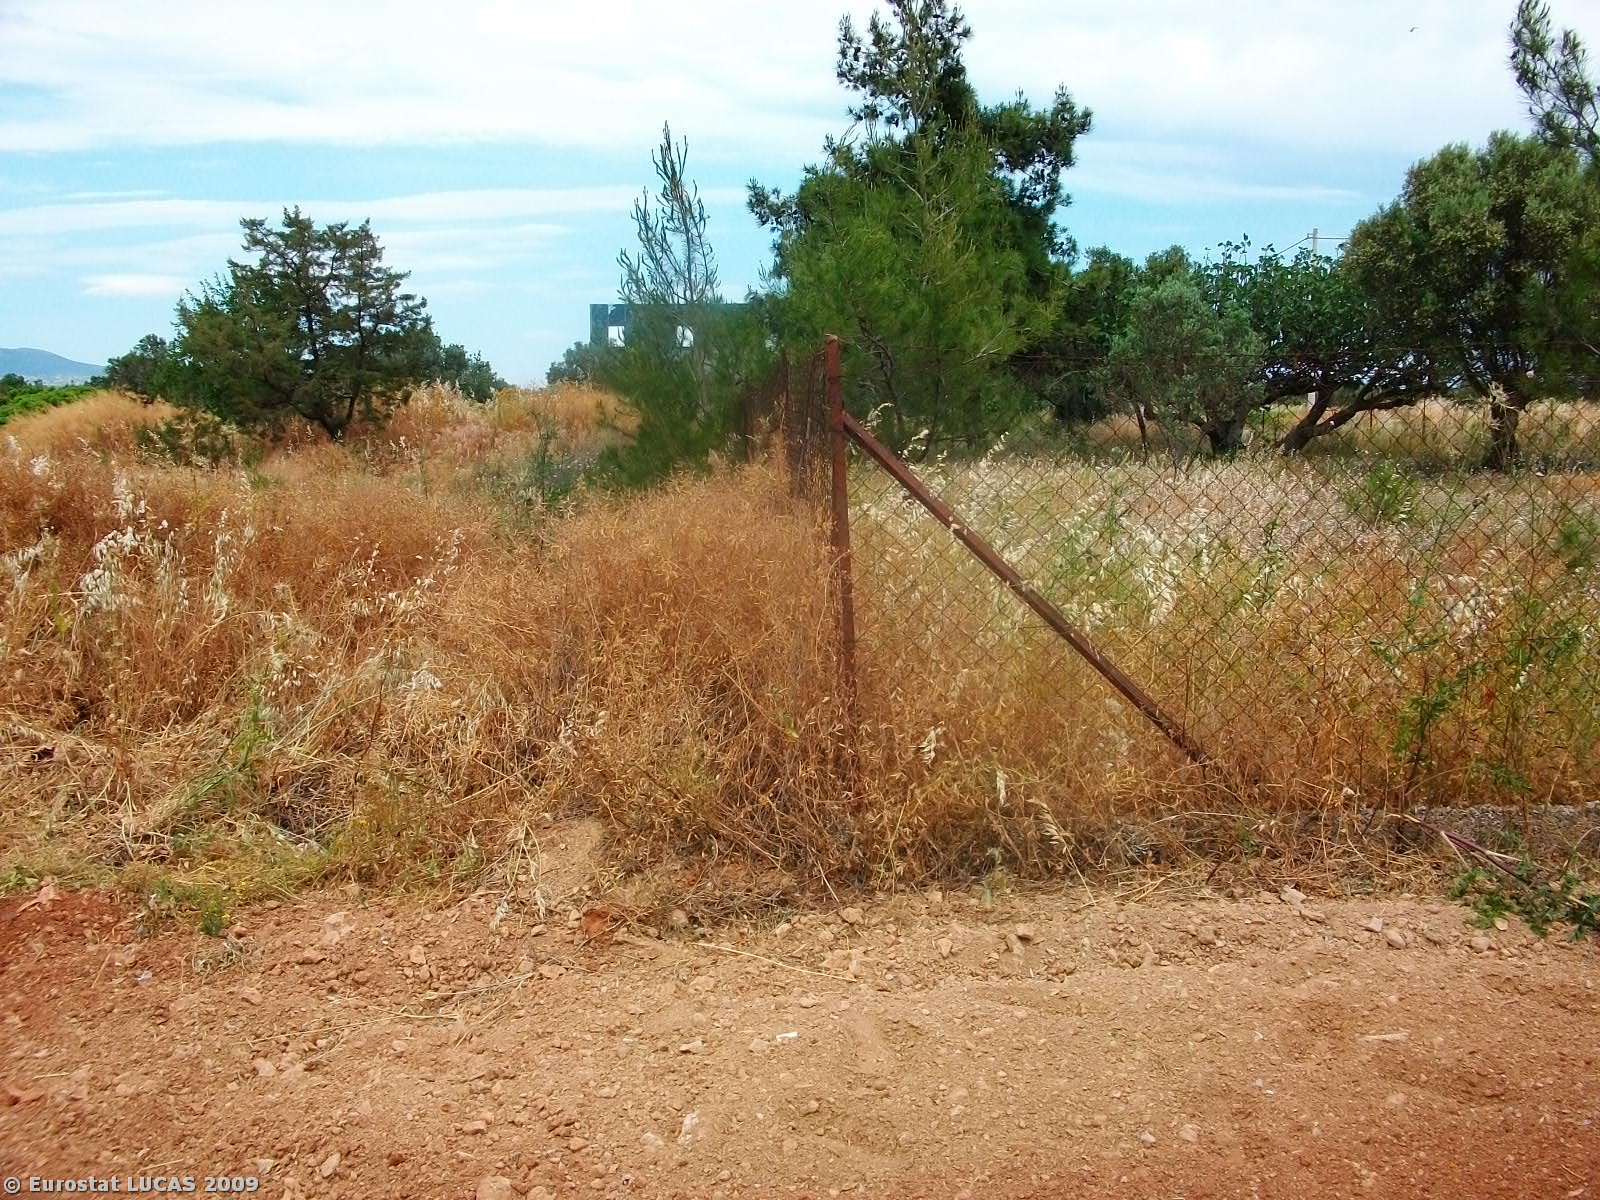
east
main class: Cropland
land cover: Olive groves
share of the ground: 50 - 75 %
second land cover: Other fruit trees and berries
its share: 10 - 25 %
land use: Agriculture (excluding fallow land and kitchen gardens)
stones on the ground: < 10 %
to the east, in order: Olive groves; Other fruit trees and berries; Fences; Spontaneously vegetated surfaces; Artificial constructions in urban areas; Fences; Paved roads, cycling and walking lanes; Railways; Paved roads, cycling and walking lanes; Fences; Electric lines; Olive groves; Spontaneously vegetated surfaces; Fences; Artificial constructions in urban areas
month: May
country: GR
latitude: 37.9161
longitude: 23.8929
